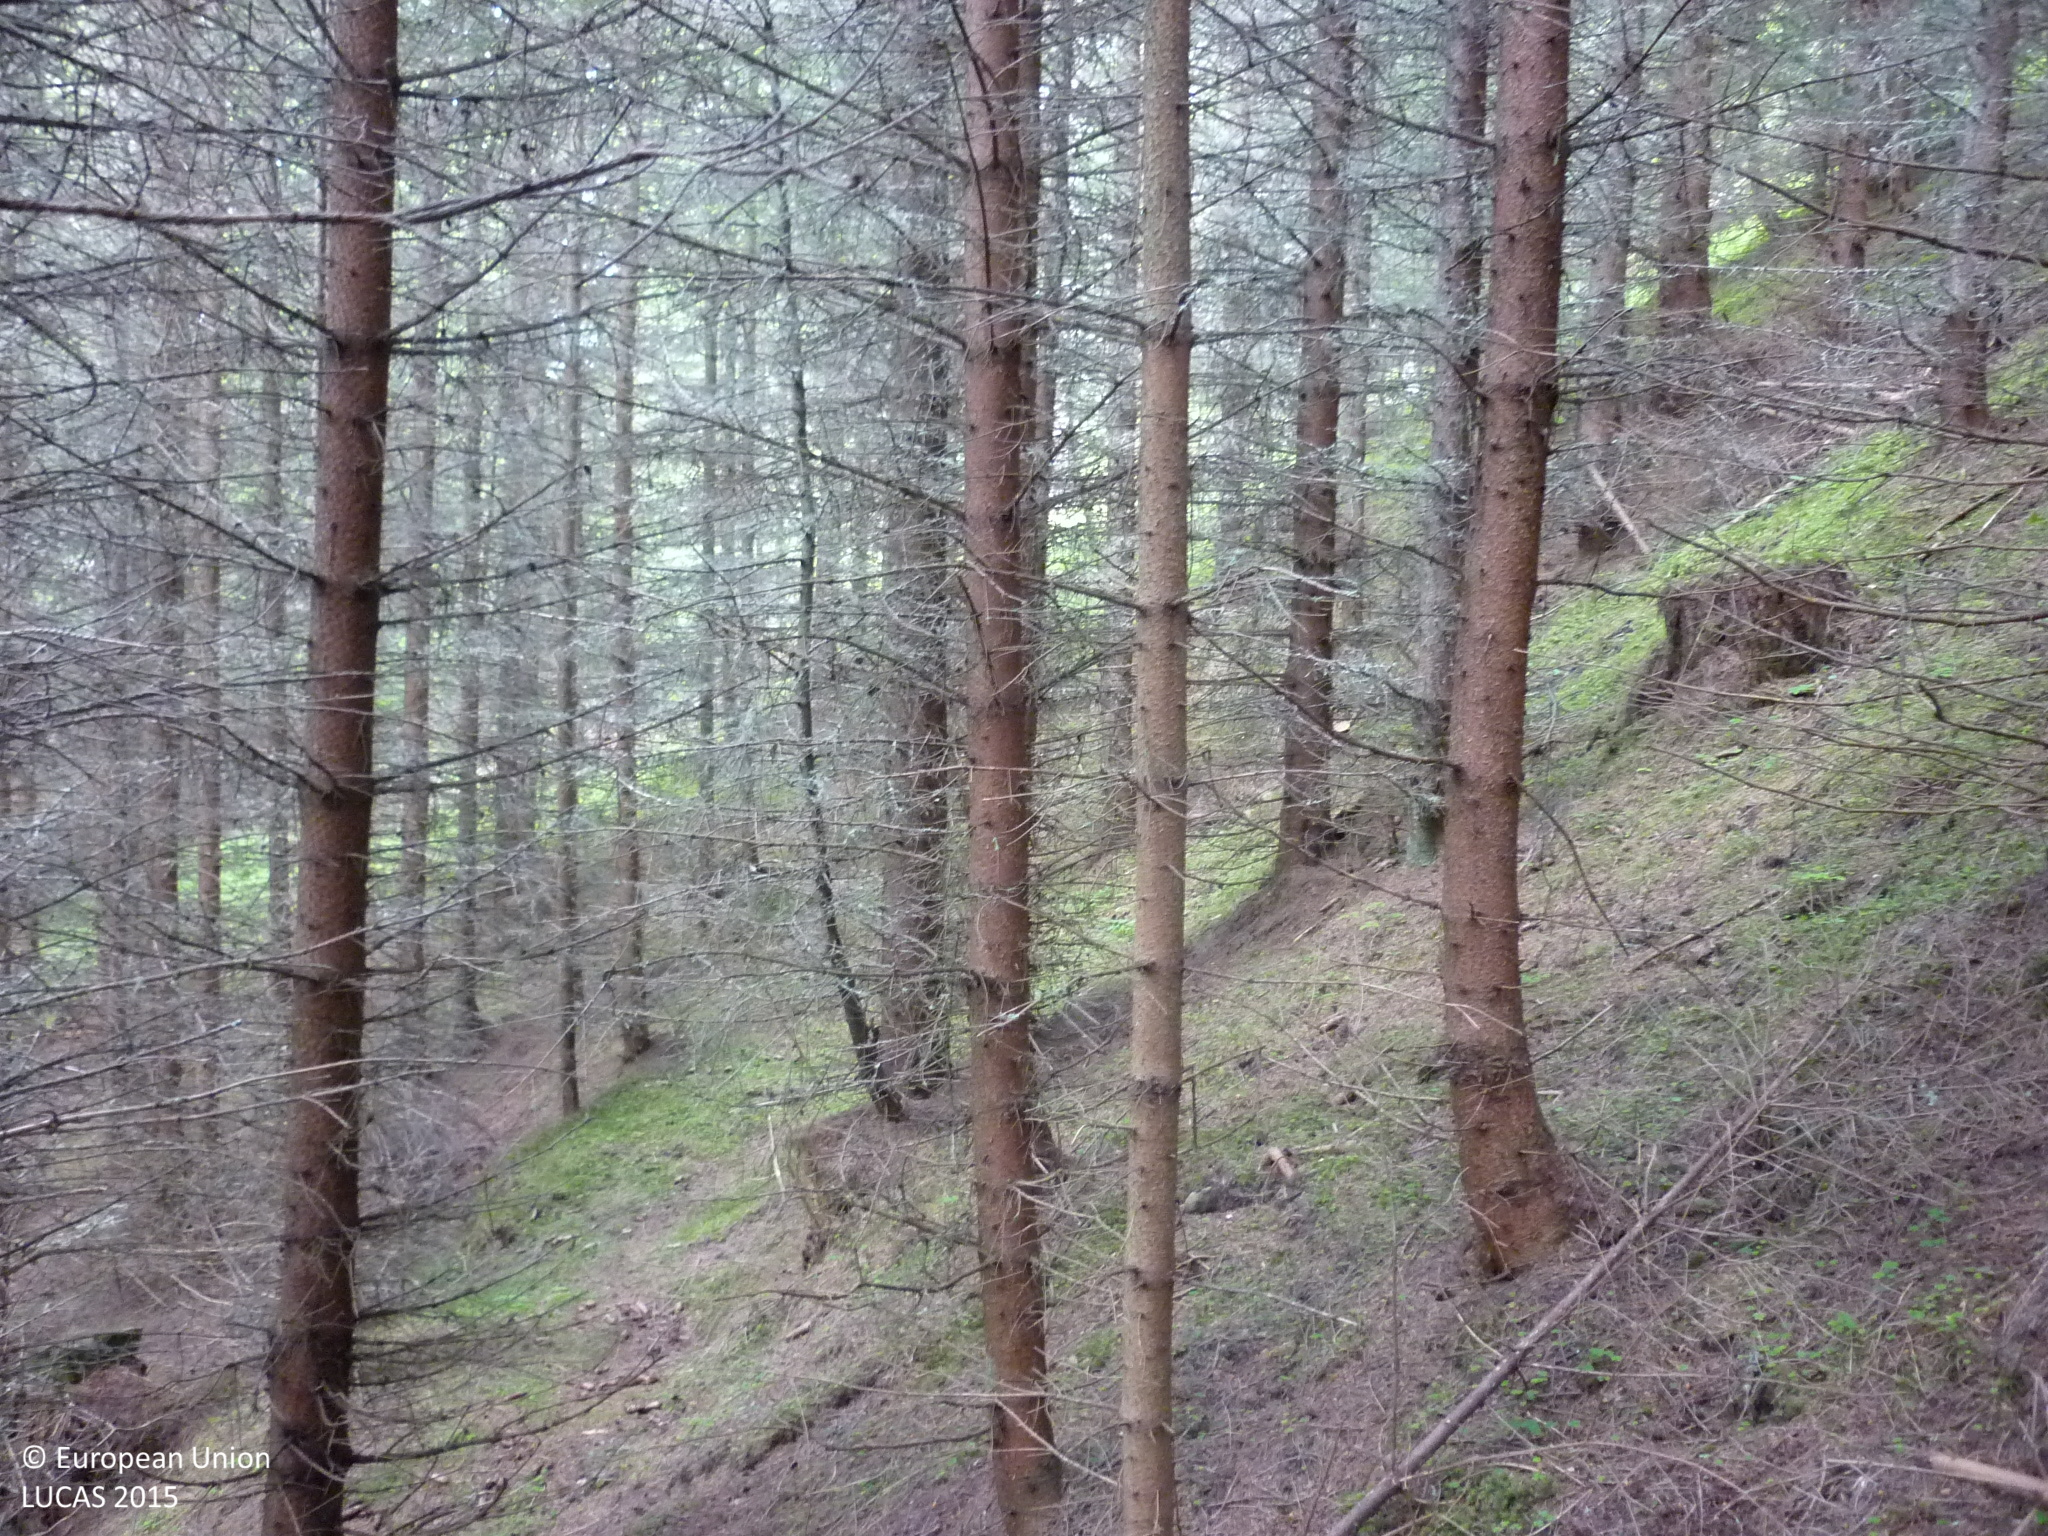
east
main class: Woodland
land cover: Spruce dominated coniferous woodland
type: alpine coniferous forest
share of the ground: > 75 %
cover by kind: coniferous forest trees 100 %
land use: Forestry
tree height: > 5 m
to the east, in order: Spruce dominated coniferous woodland; Grassland with sparse tree/shrub cover; Spruce dominated coniferous woodland; Spontaneously vegetated surfaces; Tracks; Fences; Spontaneously vegetated surfaces
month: June
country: AT
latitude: 47.1721
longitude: 14.1542
